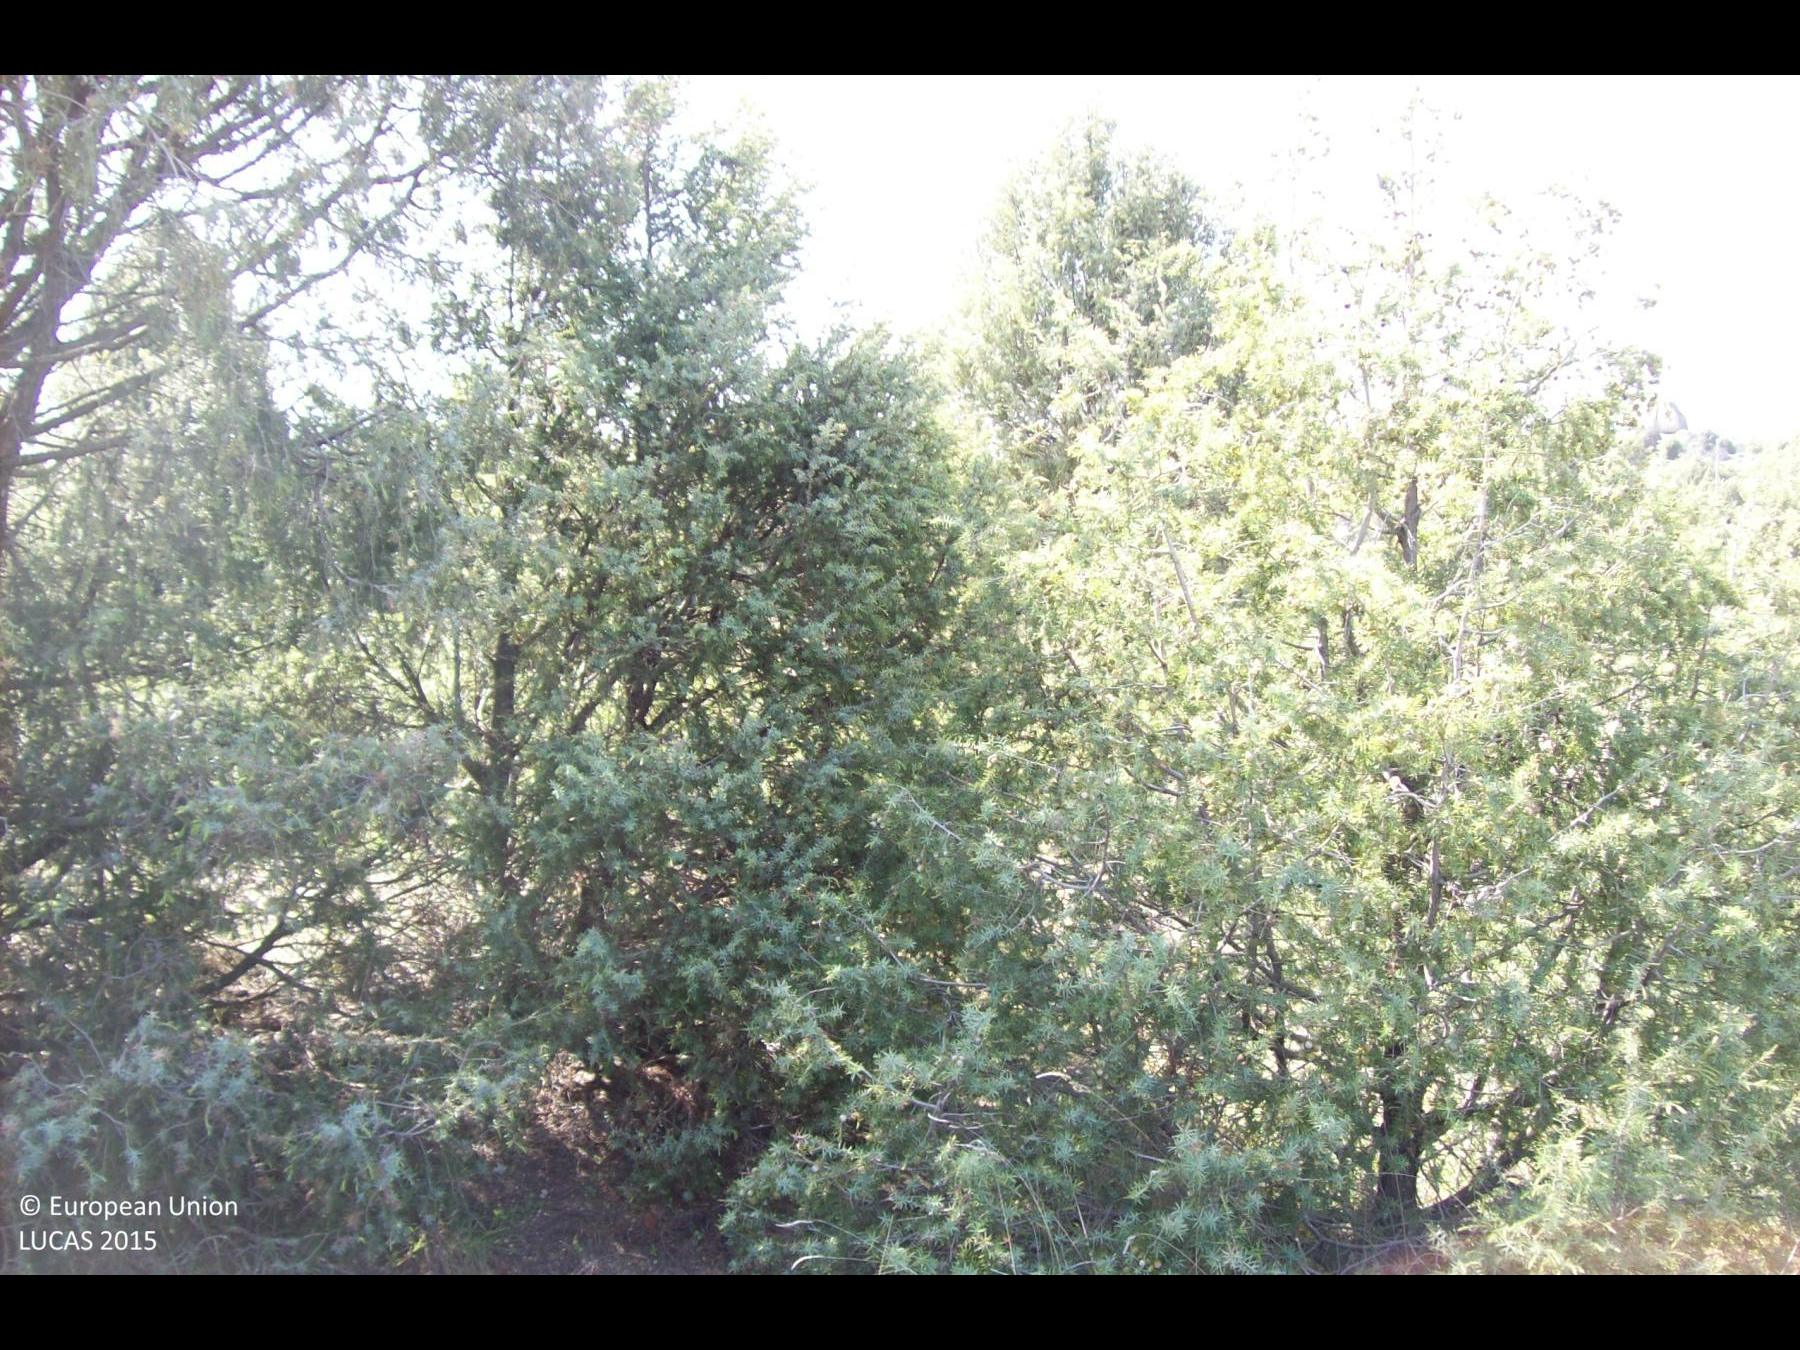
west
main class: Woodland
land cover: Other coniferous woodland
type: coniferous forest of the mediterranean region
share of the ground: > 75 %
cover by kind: herbaceous plants 35 %, coniferous forest trees 25 %, shrubs 20 %, consolidated bare surface 10 %
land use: Semi-natural and natural areas not in use
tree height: < 5 m
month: April
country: ES
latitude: 40.6093
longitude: -3.9065
